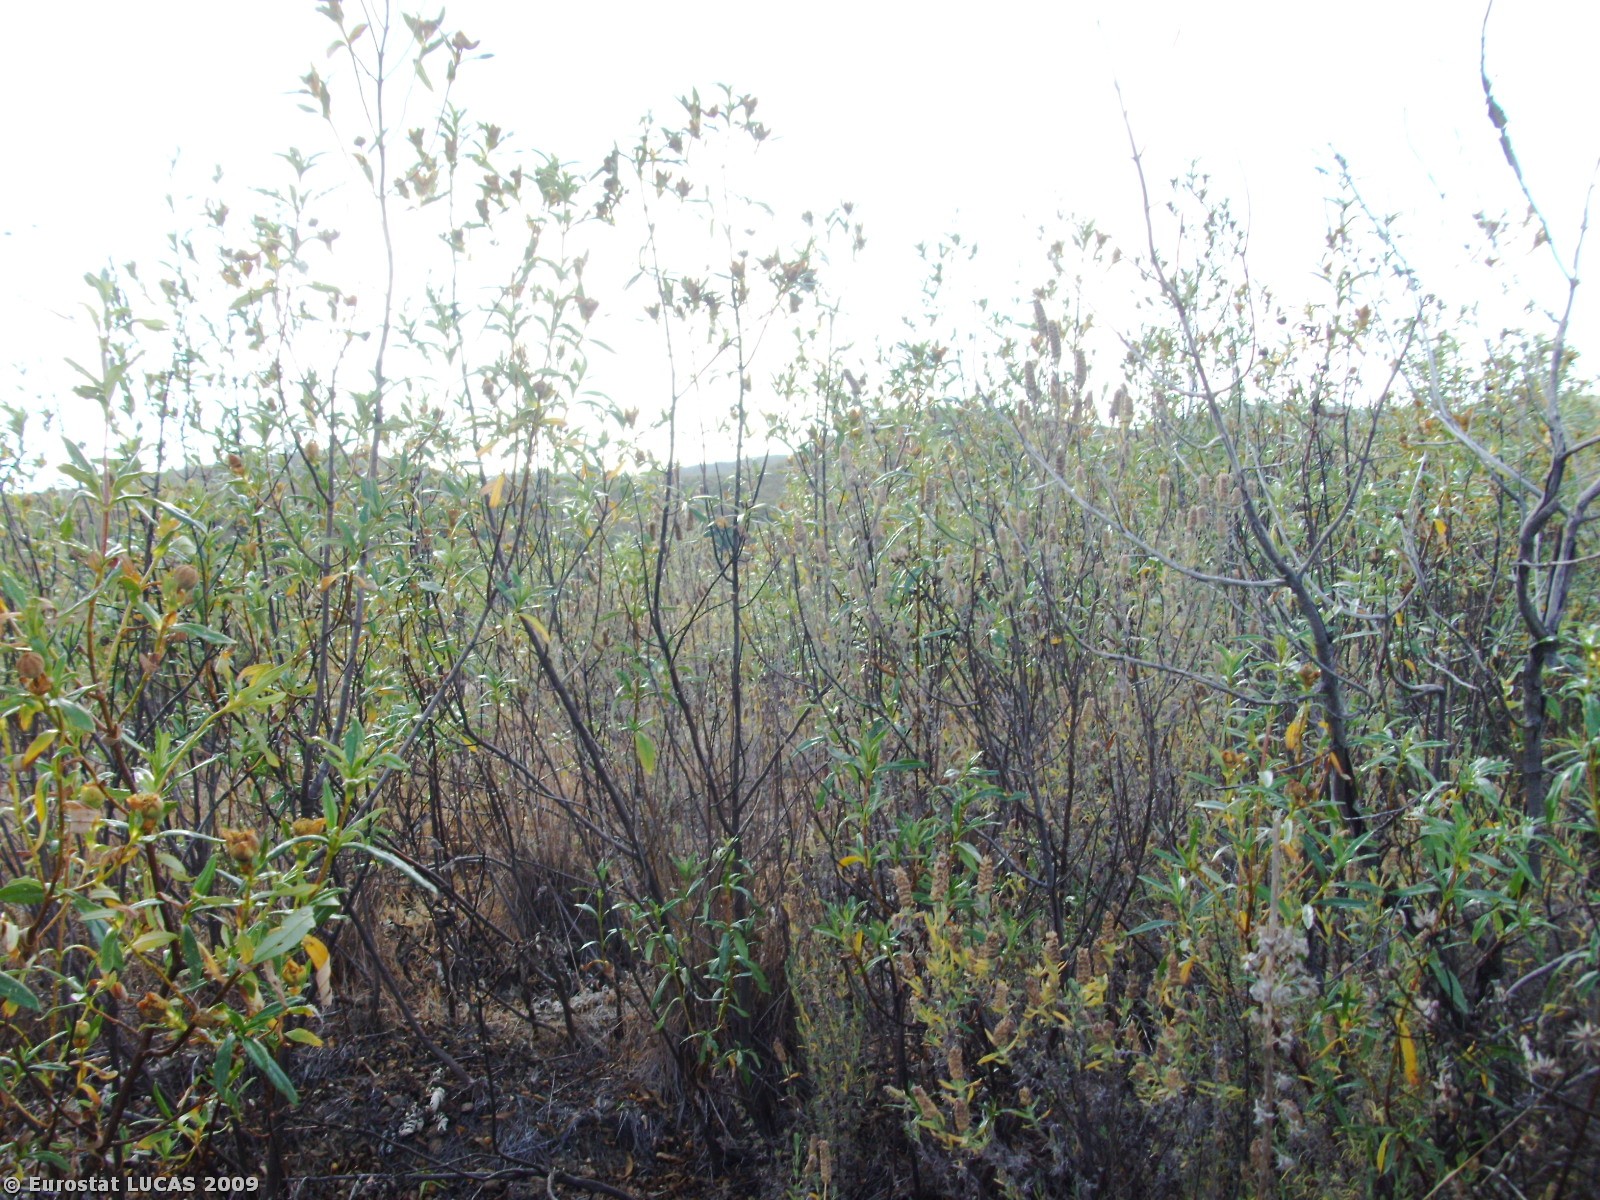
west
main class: Shrubland
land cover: Shrubland without tree cover
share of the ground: > 75 %
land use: Unused
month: June
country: PT
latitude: 37.2182
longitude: -8.7509
